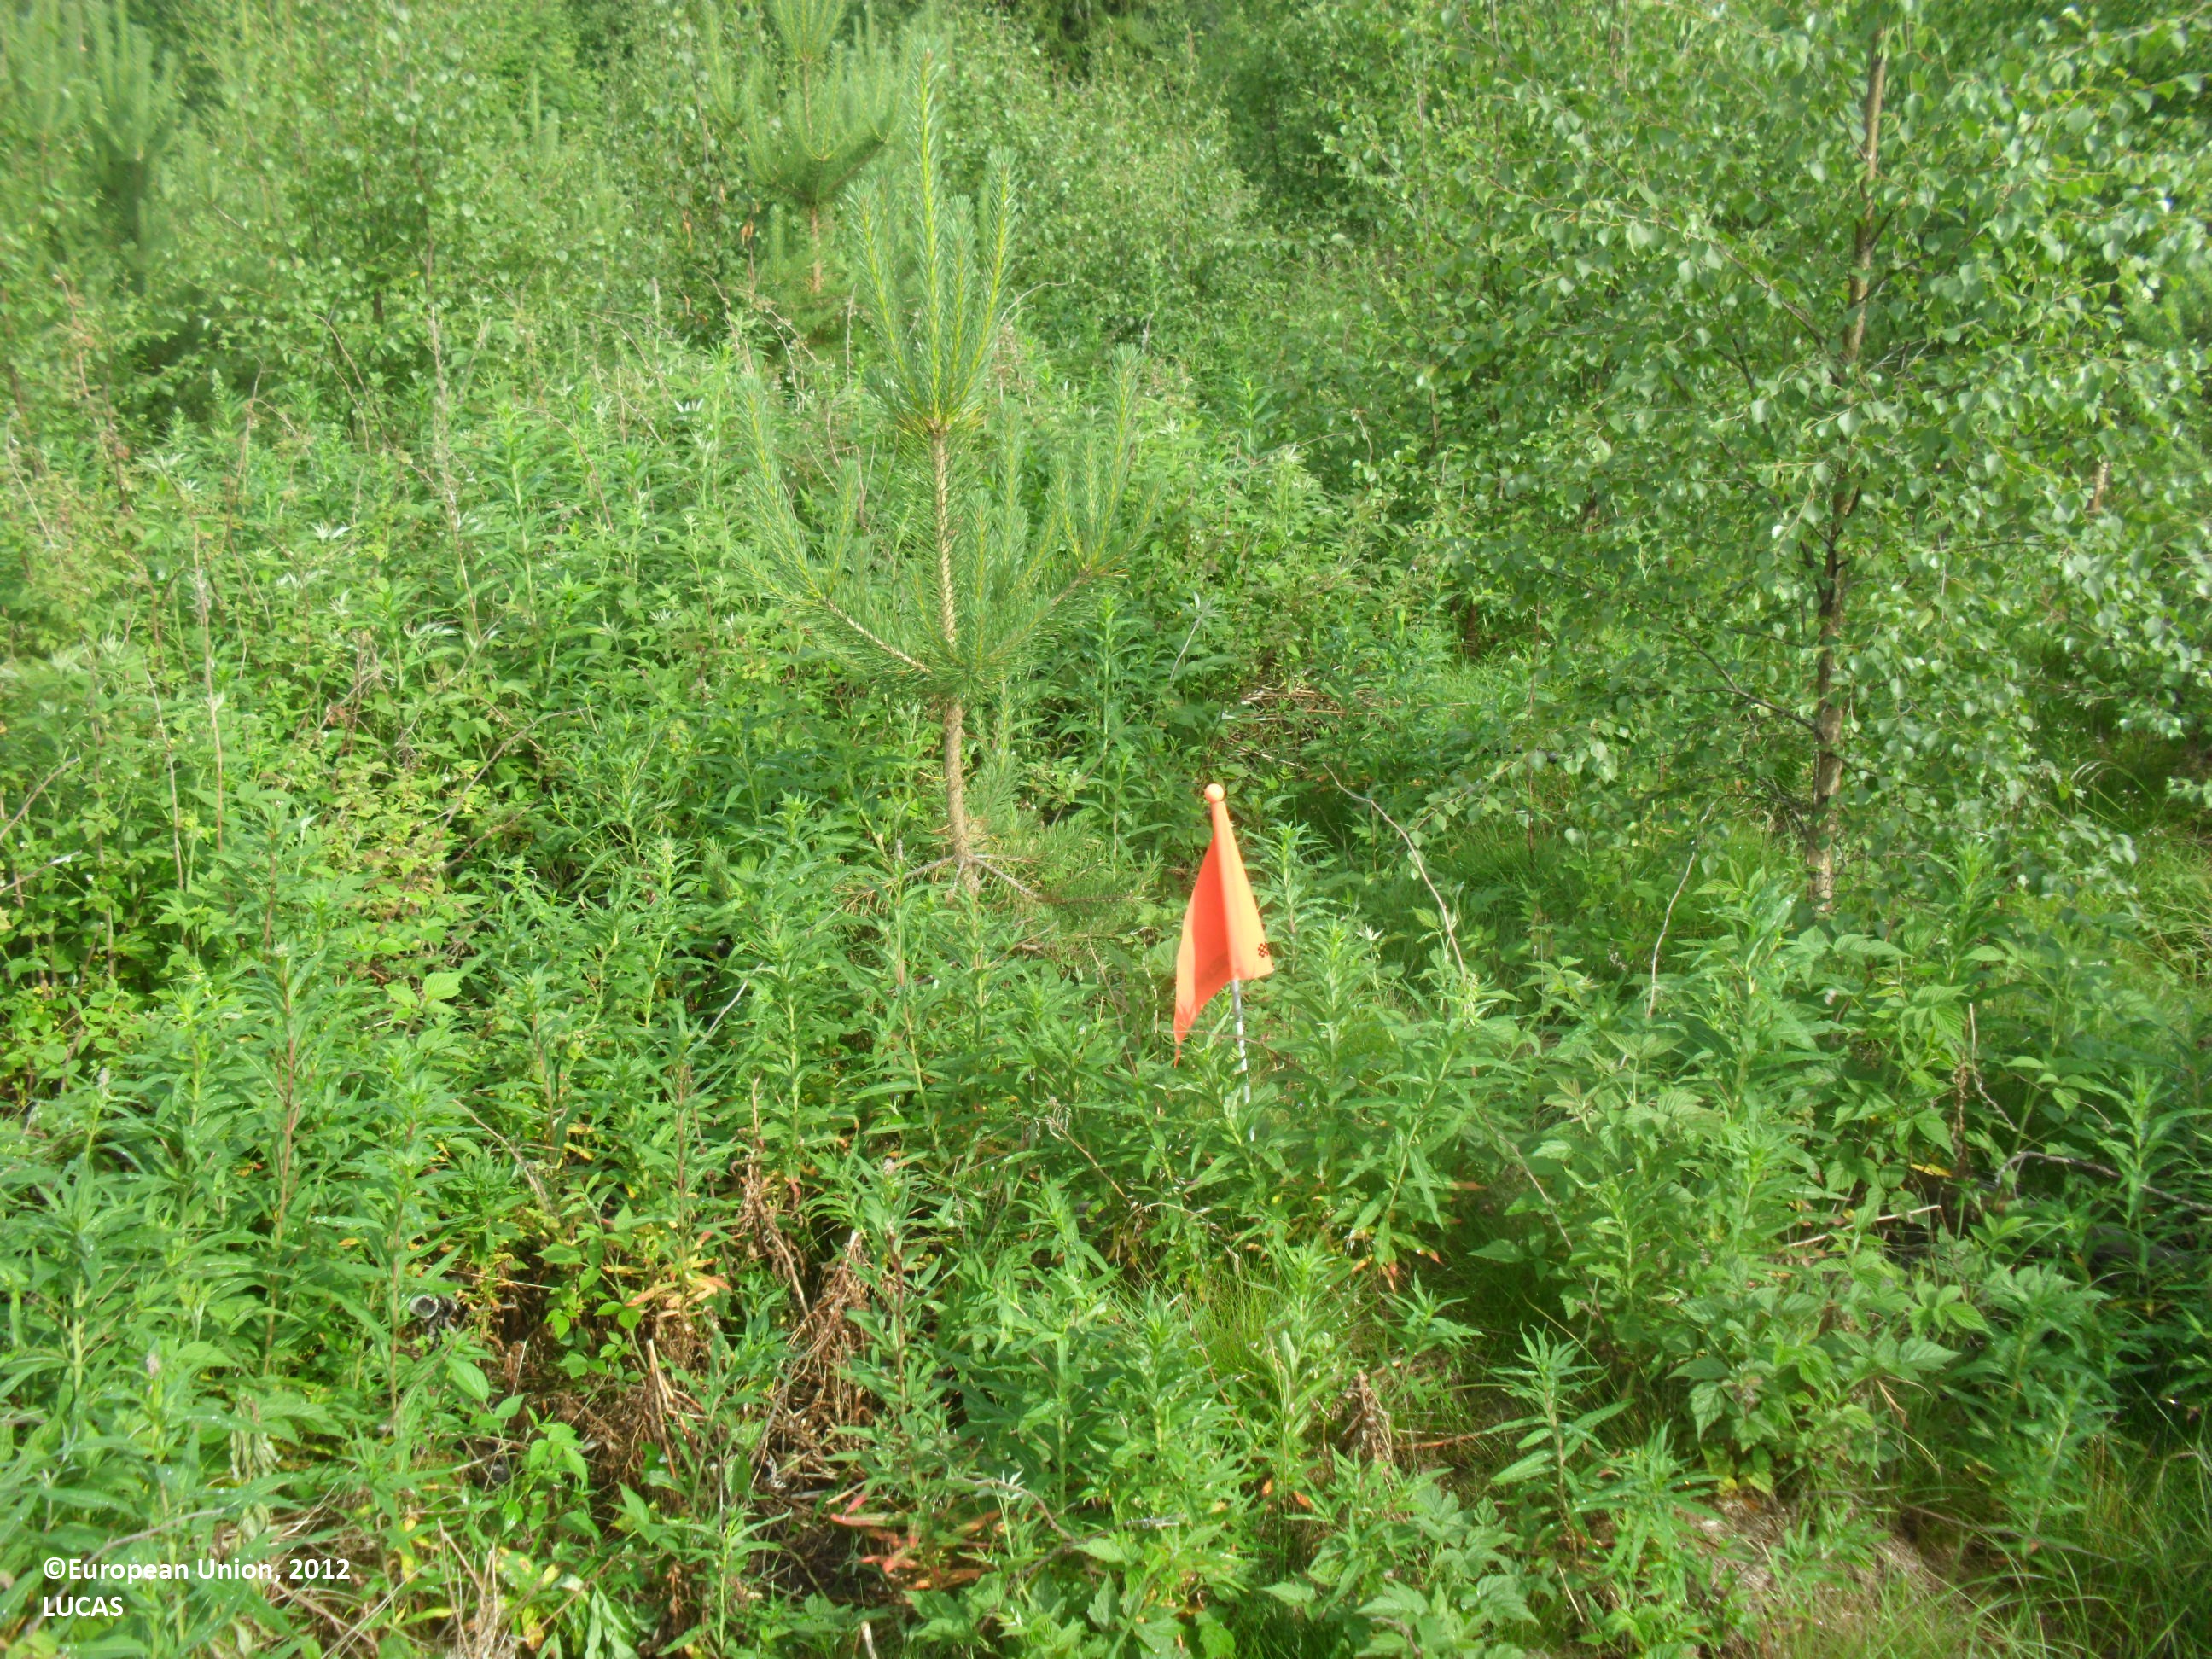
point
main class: Woodland
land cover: Other mixed woodland
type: boreal forest
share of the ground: 10 - 25 %
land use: Forestry
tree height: < 5 m
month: July
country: FI
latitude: 63.4245
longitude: 23.5877
